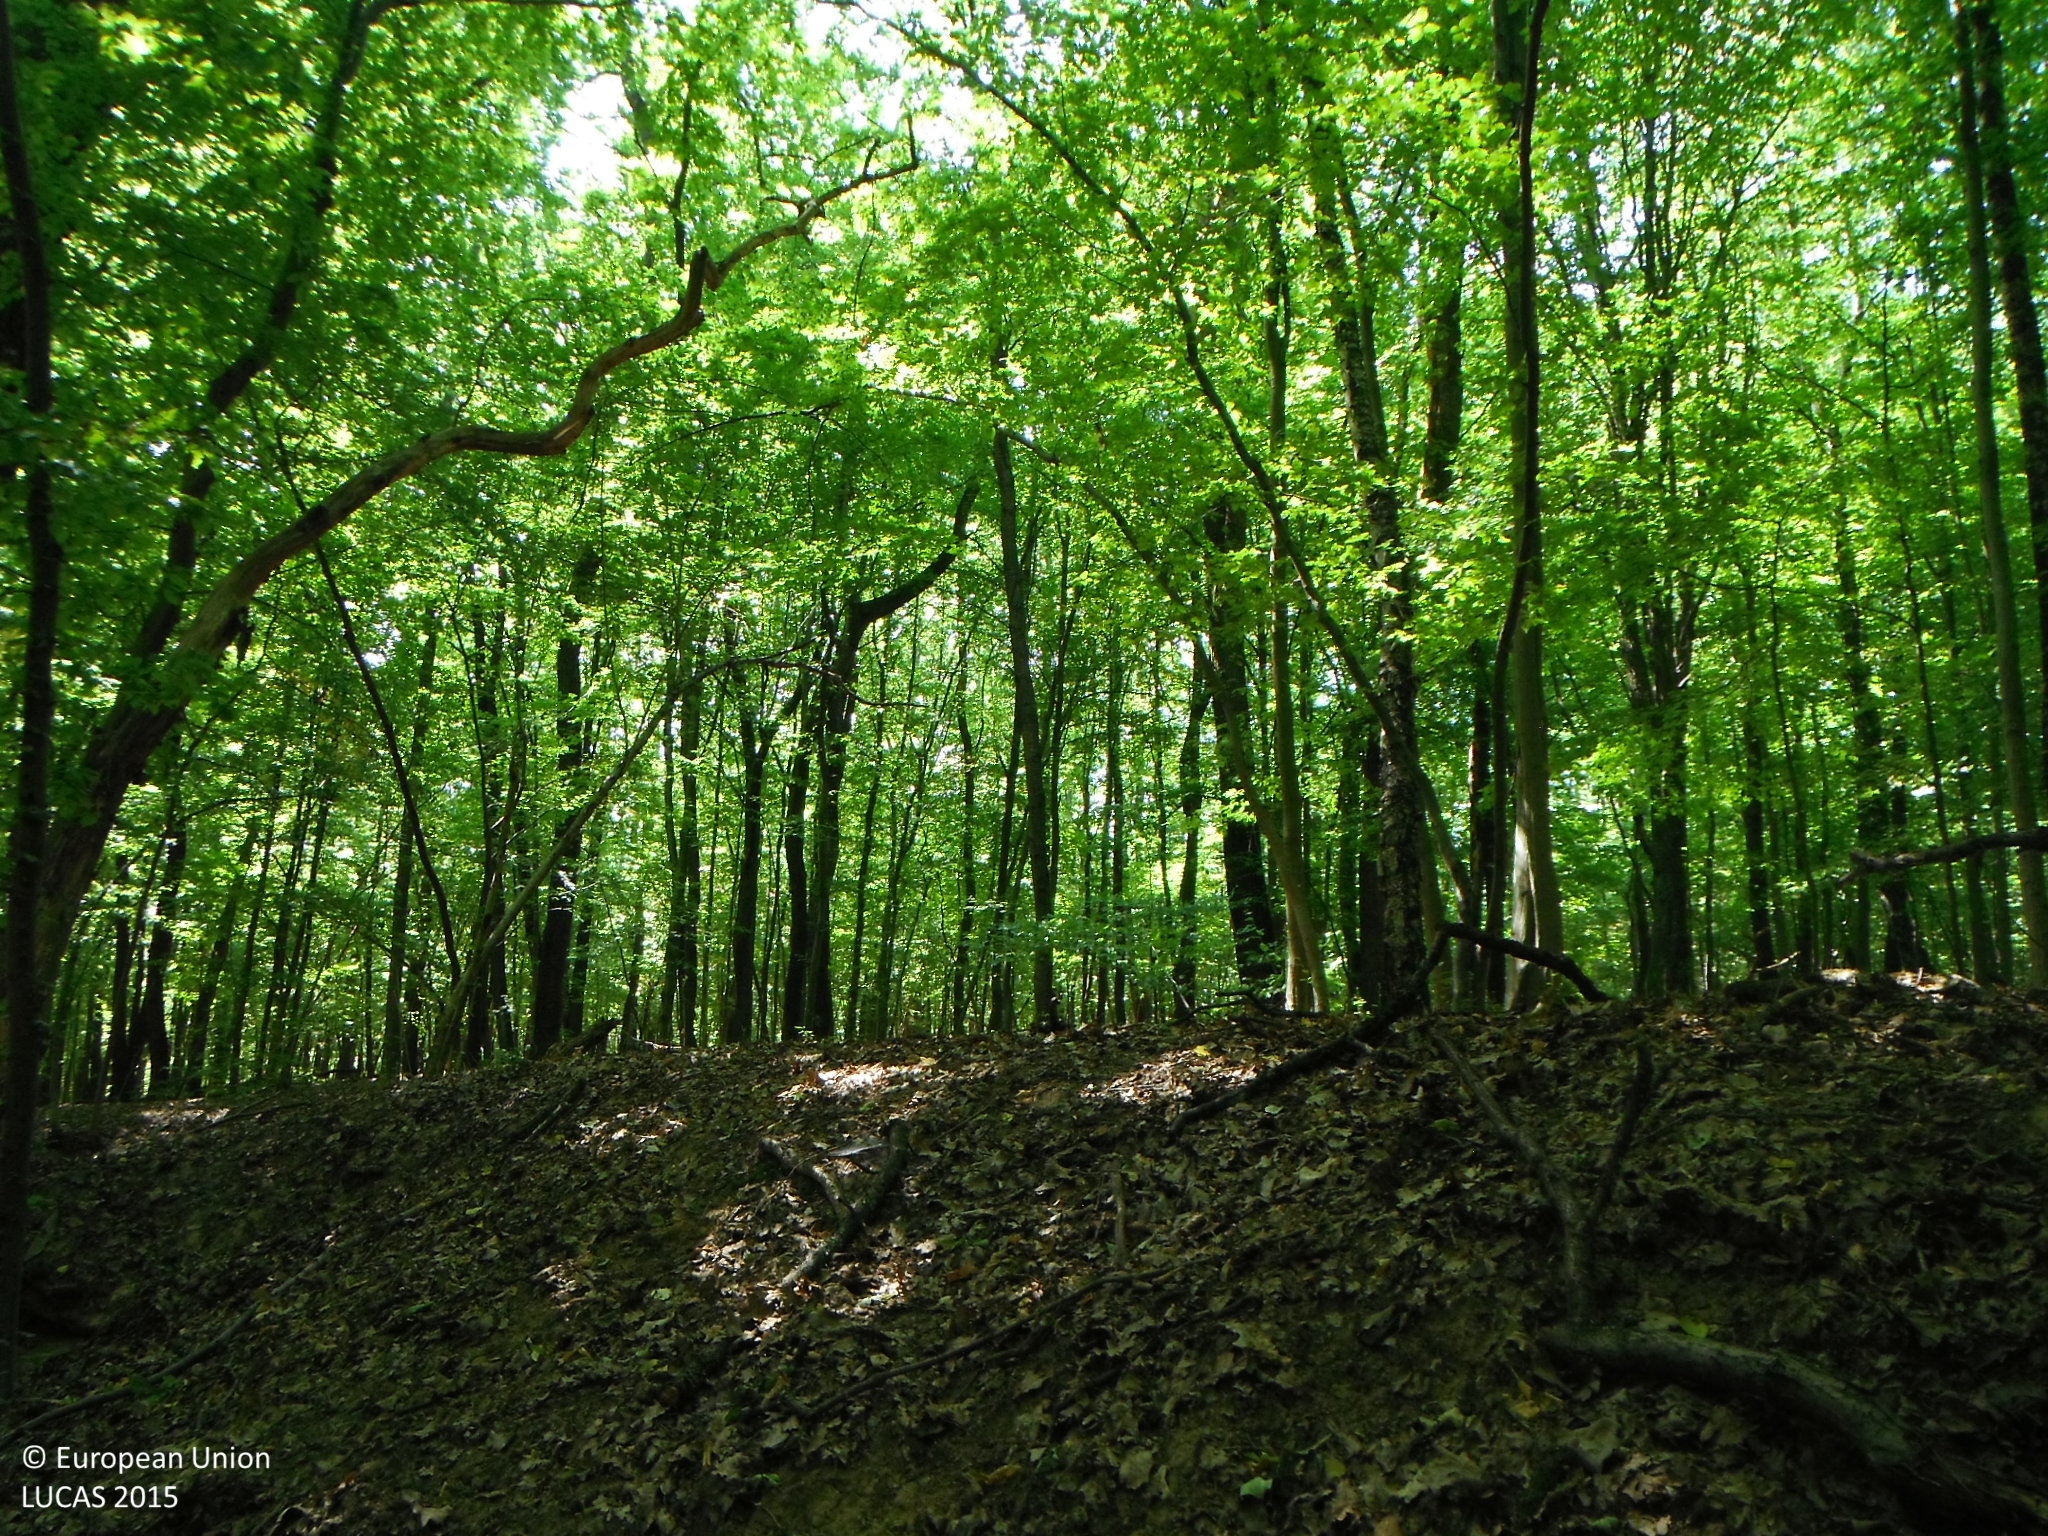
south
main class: Woodland
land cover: Broadleaved woodland
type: mesophytic deciduous forest
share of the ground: > 75 %
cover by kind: broadleaved forest trees 100 %
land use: Forestry
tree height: > 5 m
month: July
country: SK
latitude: 48.2484
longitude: 19.0569
